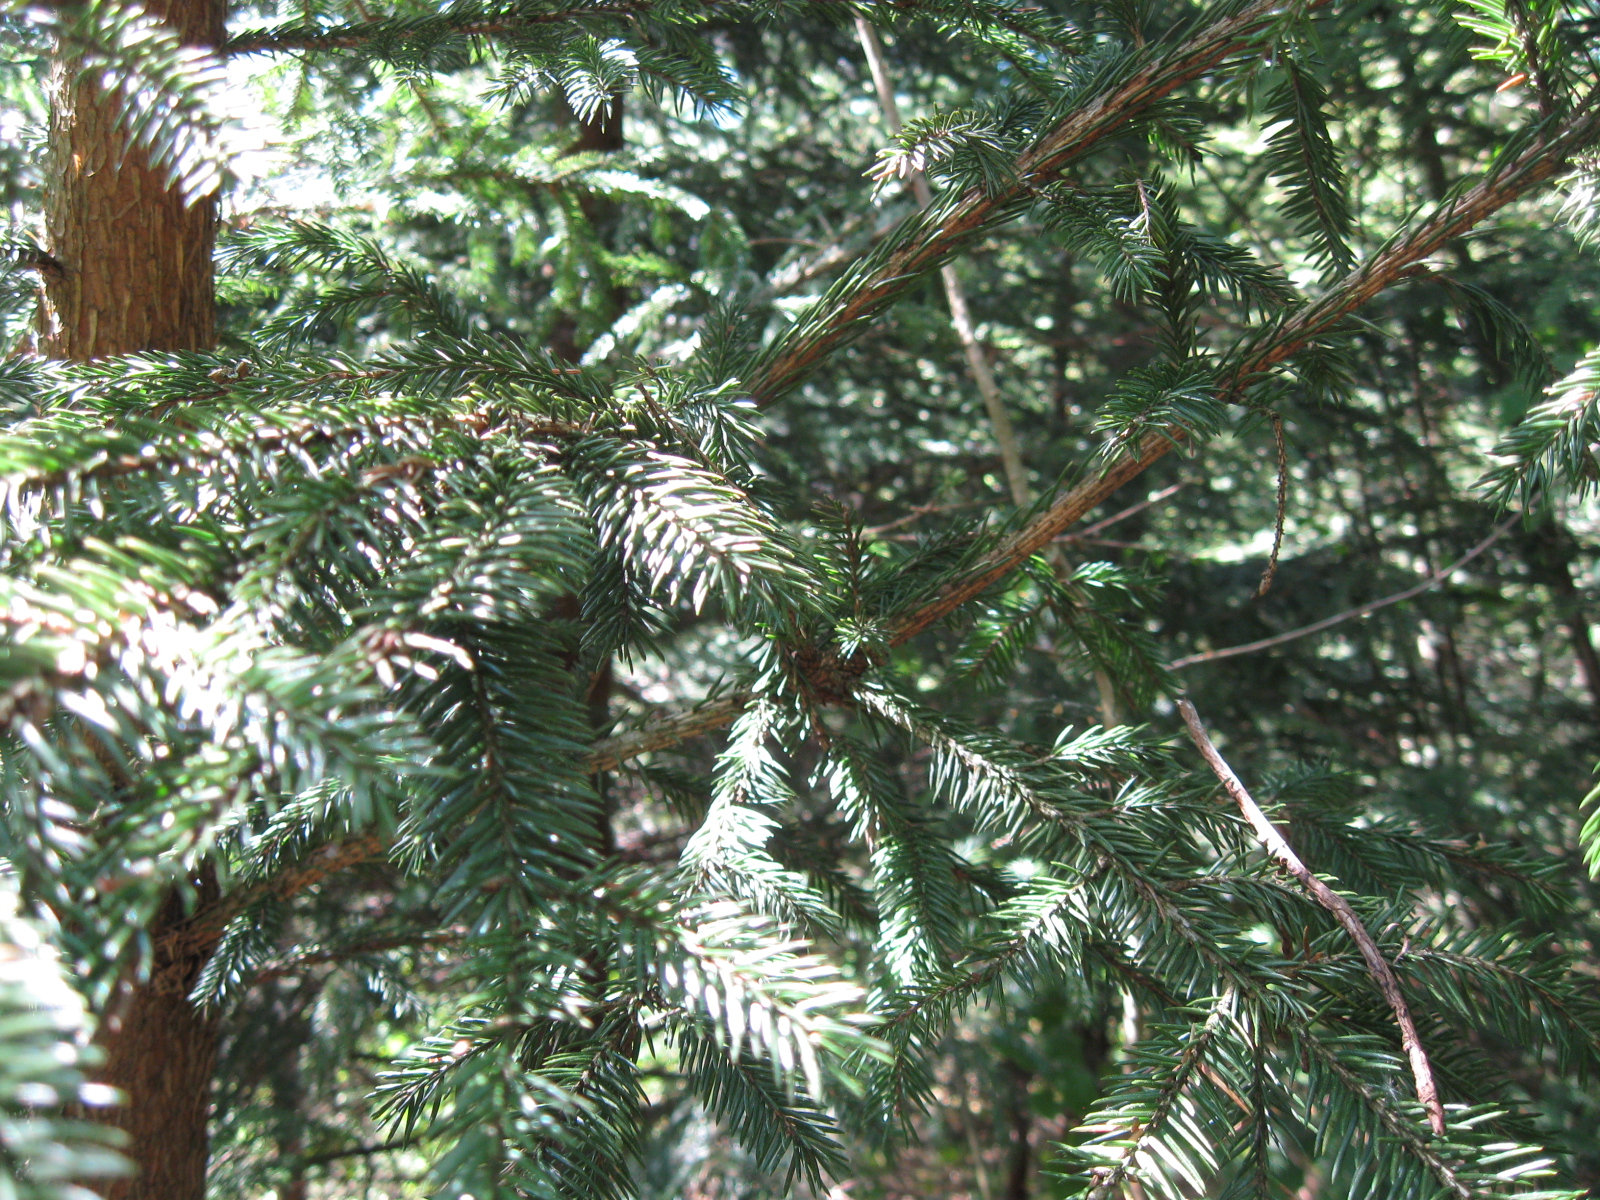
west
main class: Woodland
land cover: Spruce dominated mixed woodland
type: hemiboreal forest and nemoral coniferous forest and mixed broadleaved-coniferous forest
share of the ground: > 75 %
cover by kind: coniferous forest trees 75 %, broadleaved forest trees 25 %
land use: Forestry
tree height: > 5 m
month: May
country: LT
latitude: 54.2690
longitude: 23.2990
